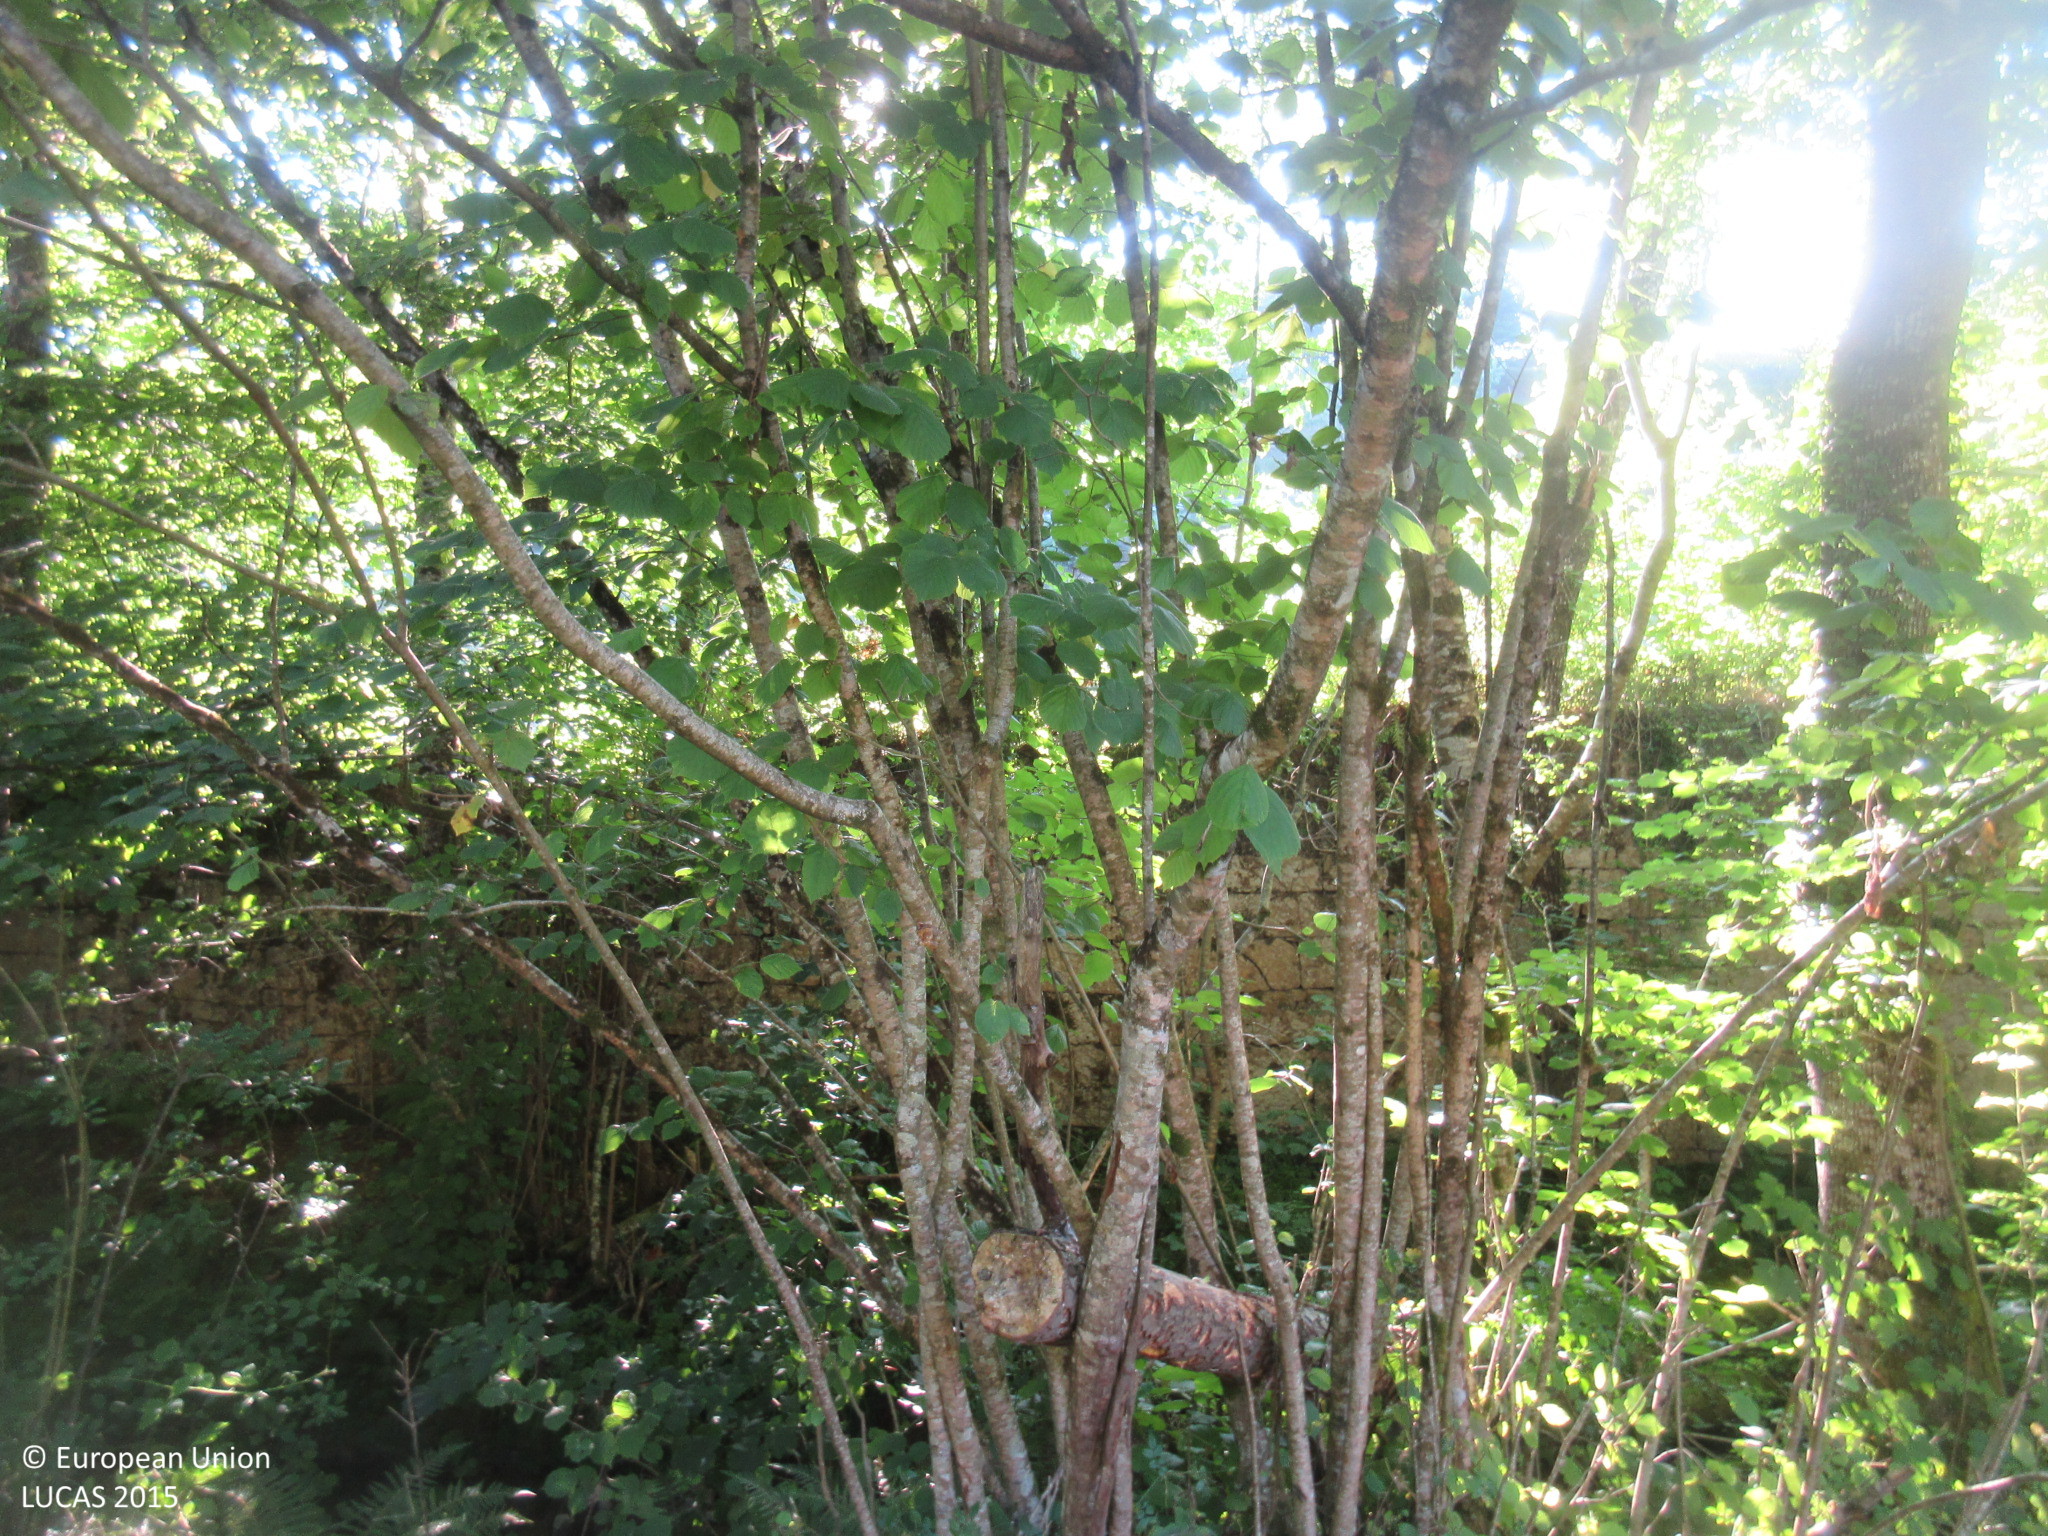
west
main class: Grassland
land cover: Grassland without tree/shrub cover
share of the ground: > 75 %
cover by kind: herbaceous plants 100 %
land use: Agriculture (excluding fallow land and kitchen gardens)
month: July
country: ES
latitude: 43.3537
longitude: -5.0612
